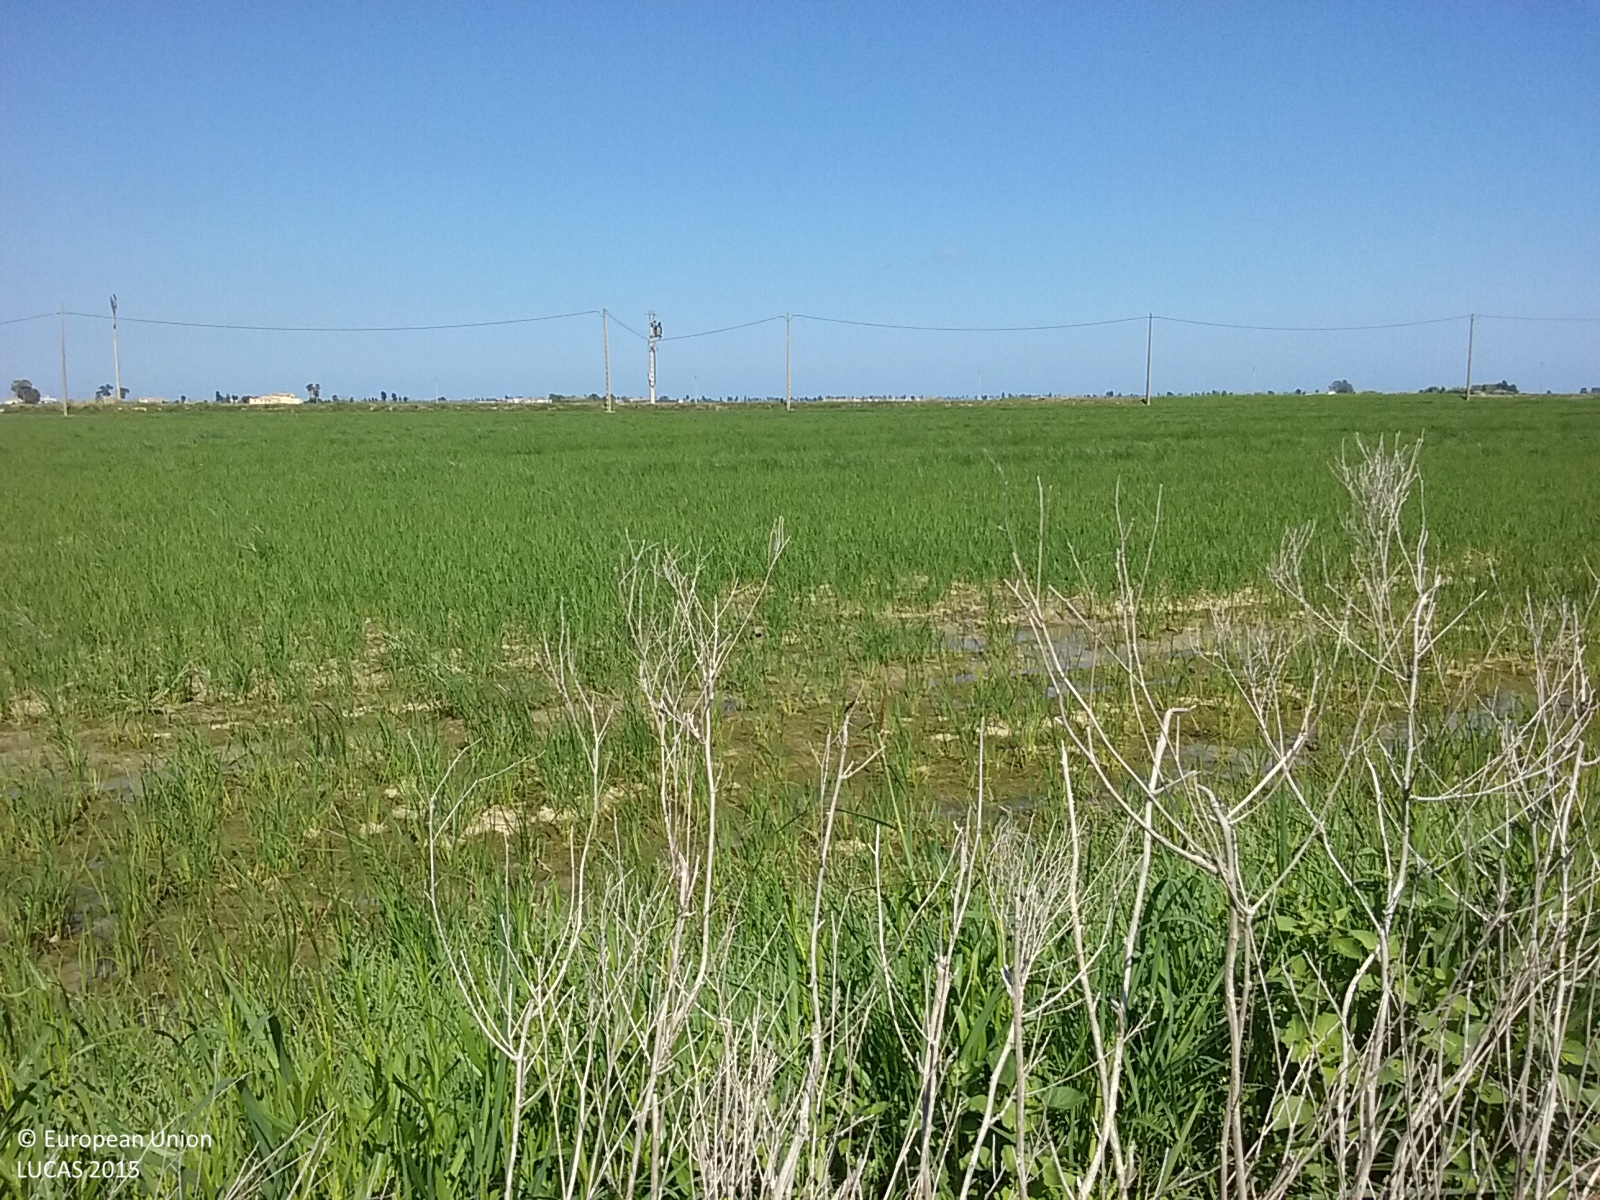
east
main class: Cropland
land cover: Rice
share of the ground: 50 - 75 %
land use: Agriculture (excluding fallow land and kitchen gardens)
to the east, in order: Rice; Other structural elements; Rice; Ditches and canals; Grass margins; Tracks; Electric lines; Tracks; Grass margins; Rice
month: June
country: ES
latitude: 40.6785
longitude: 0.6845
